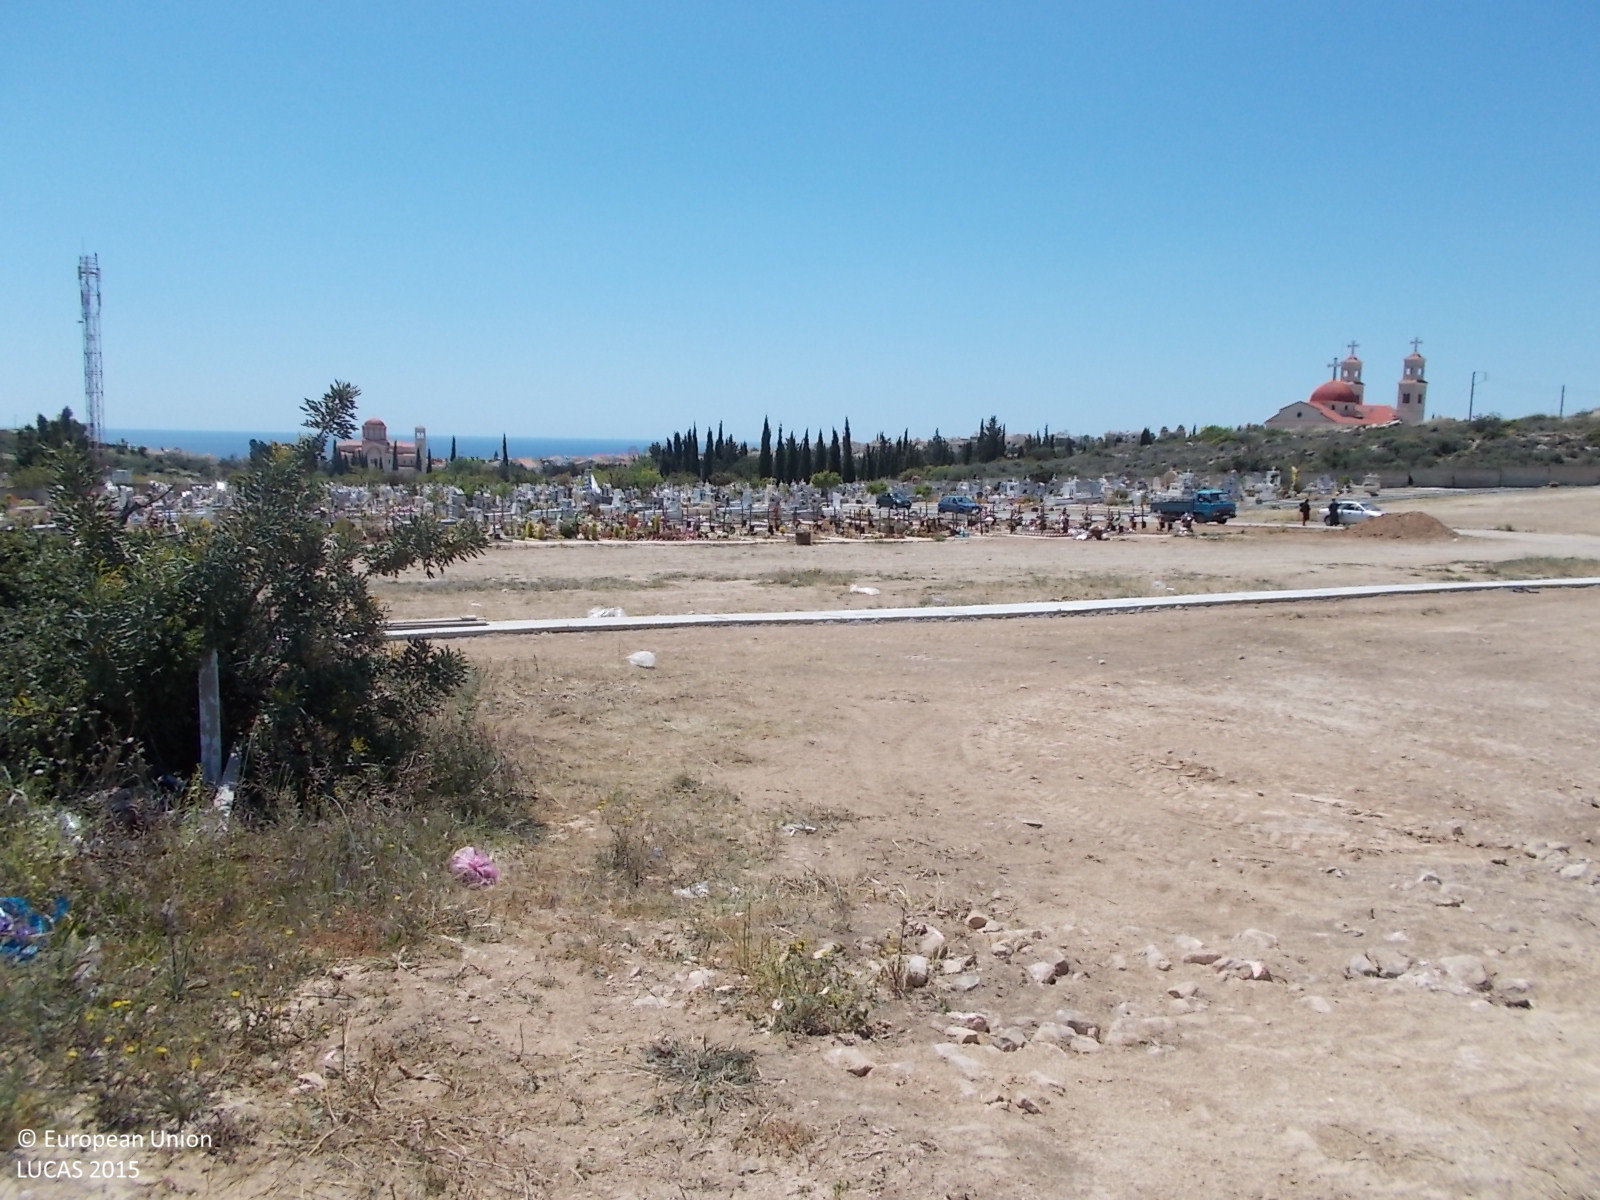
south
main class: Shrubland
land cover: Shrubland without tree cover
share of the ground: 50 - 75 %
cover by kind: shrubs 50 %, unconsolidated bare surface 30 %, herbaceous plants 20 %
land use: Semi-natural and natural areas not in use
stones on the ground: < 10 %
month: April
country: CY
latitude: 34.7208
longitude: 33.0658
